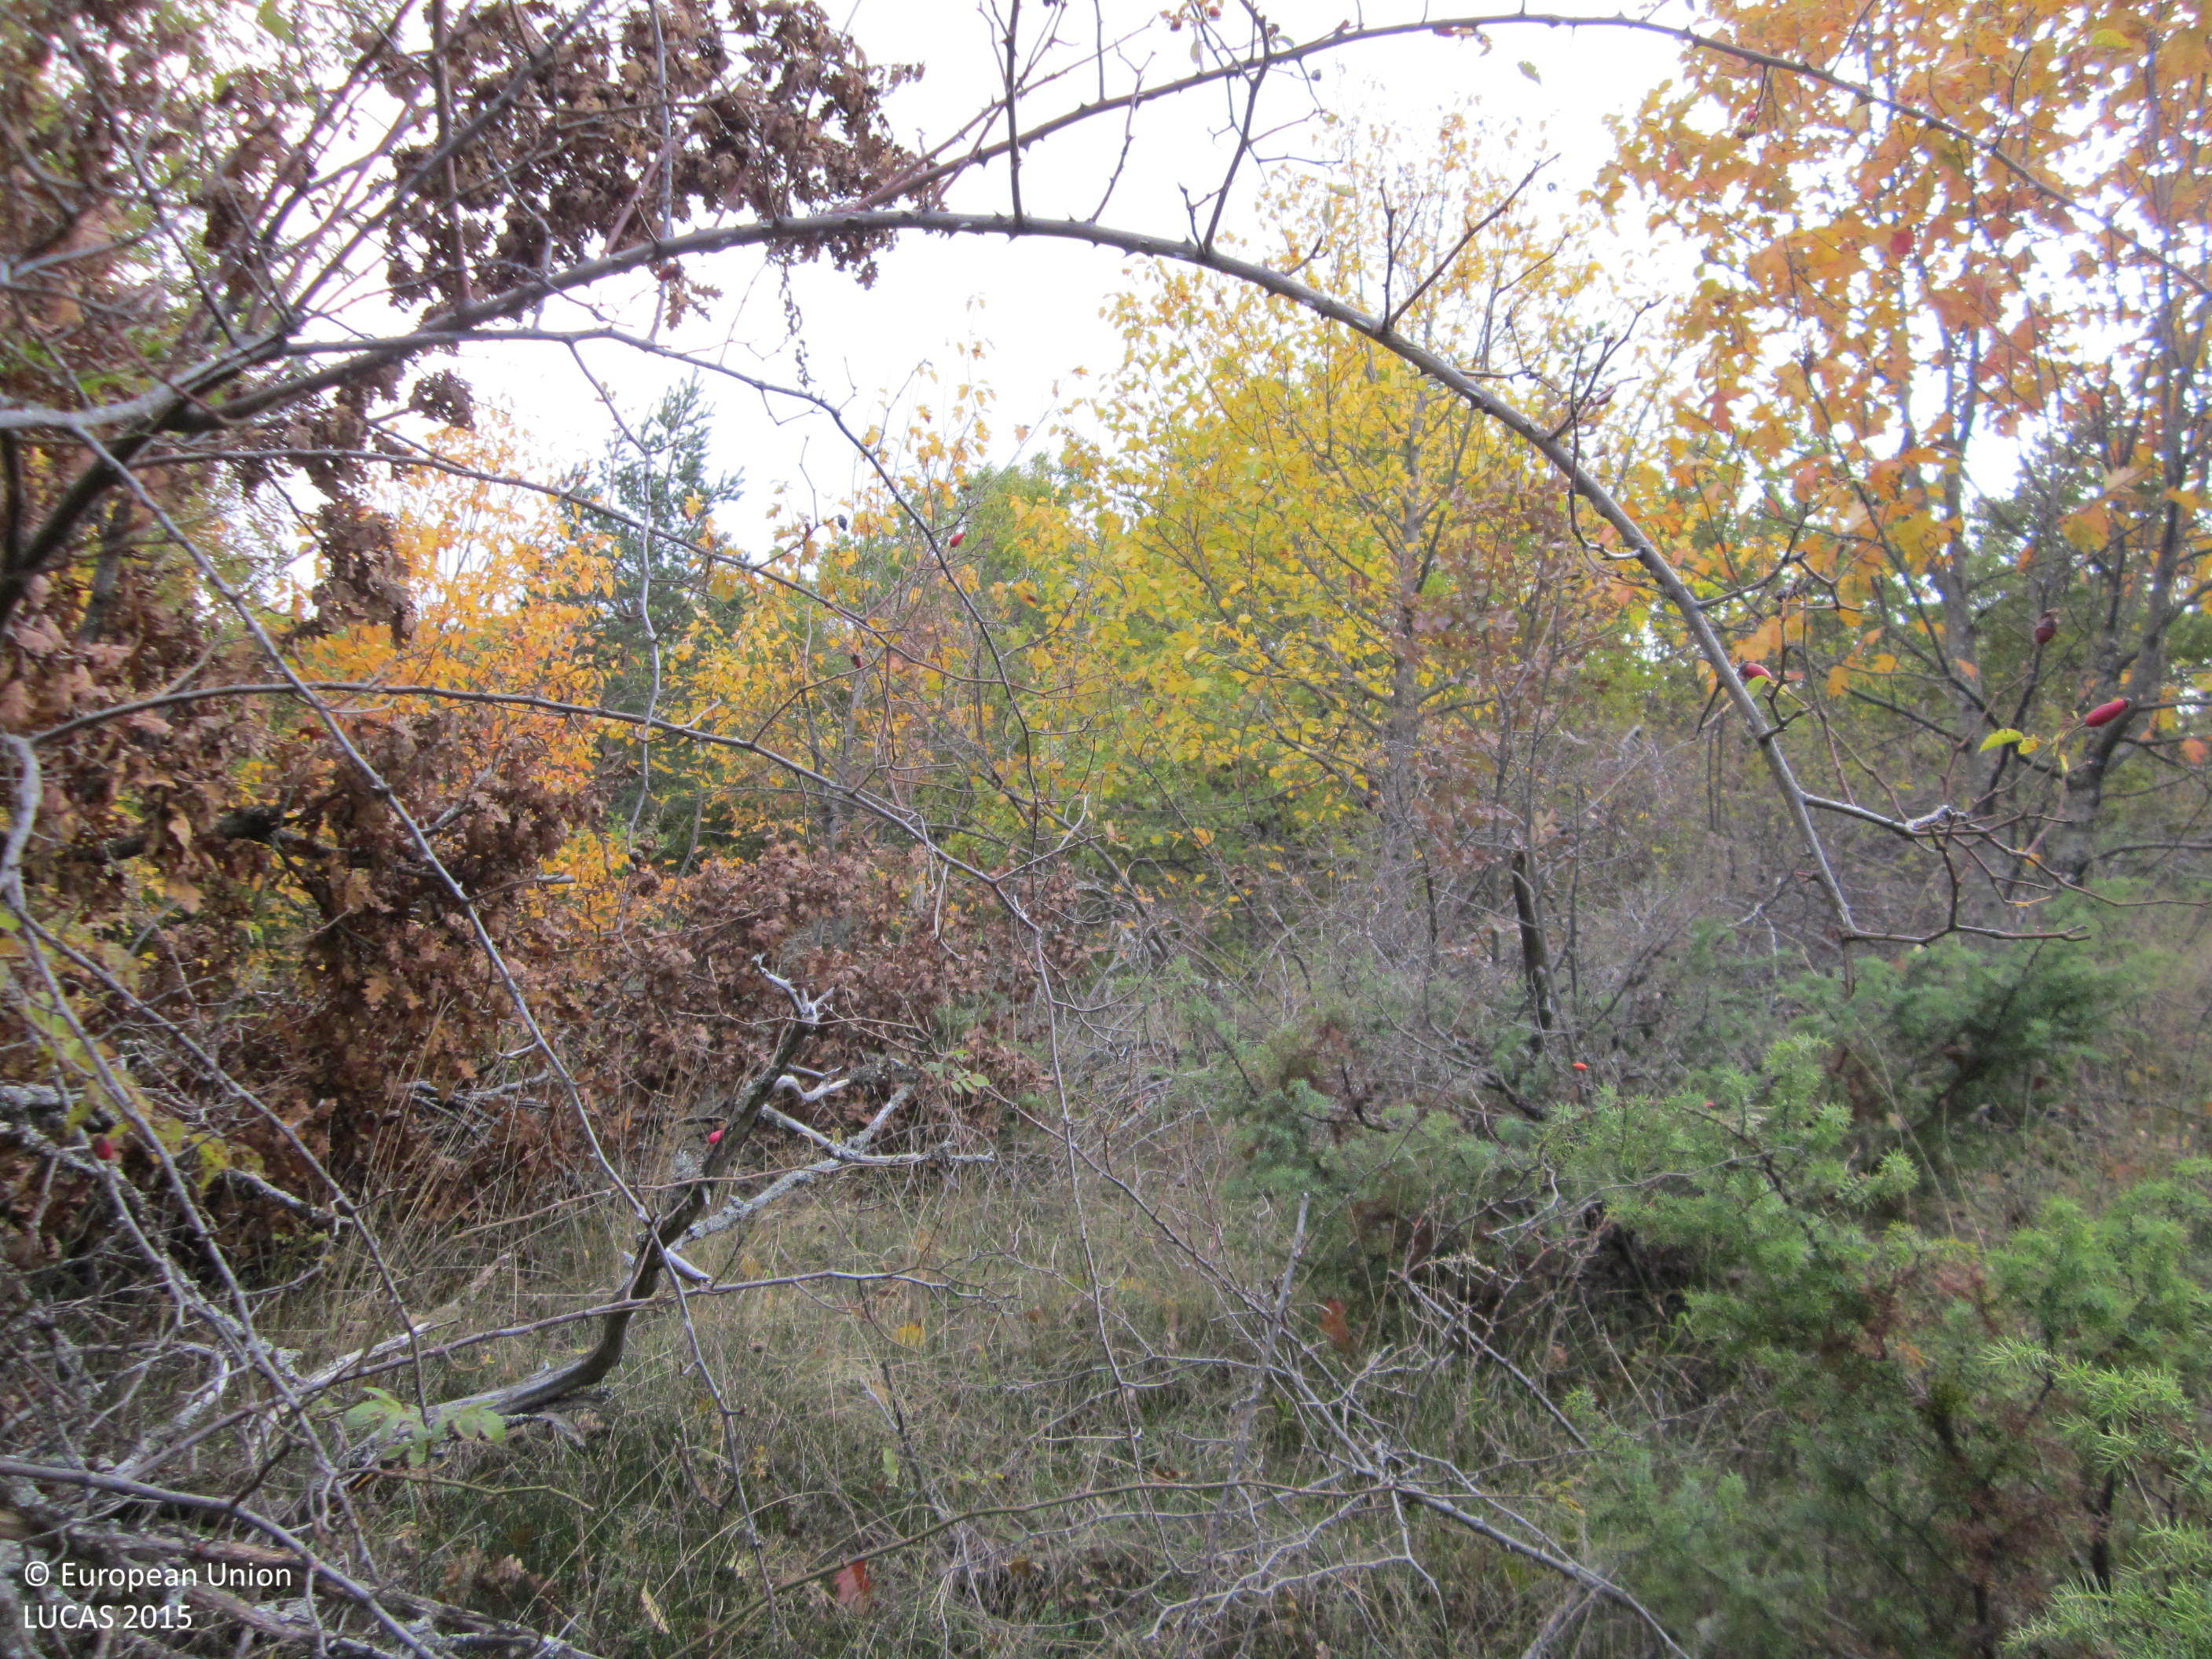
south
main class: Woodland
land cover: Broadleaved woodland
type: mesophytic deciduous forest
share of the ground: 50 - 75 %
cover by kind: broadleaved forest trees 50 %, herbaceous plants 25 %, shrubs 20 %, coniferous forest trees 5 %
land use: Forestry
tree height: > 5 m
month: November
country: BG
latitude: 41.3770
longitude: 25.8581
